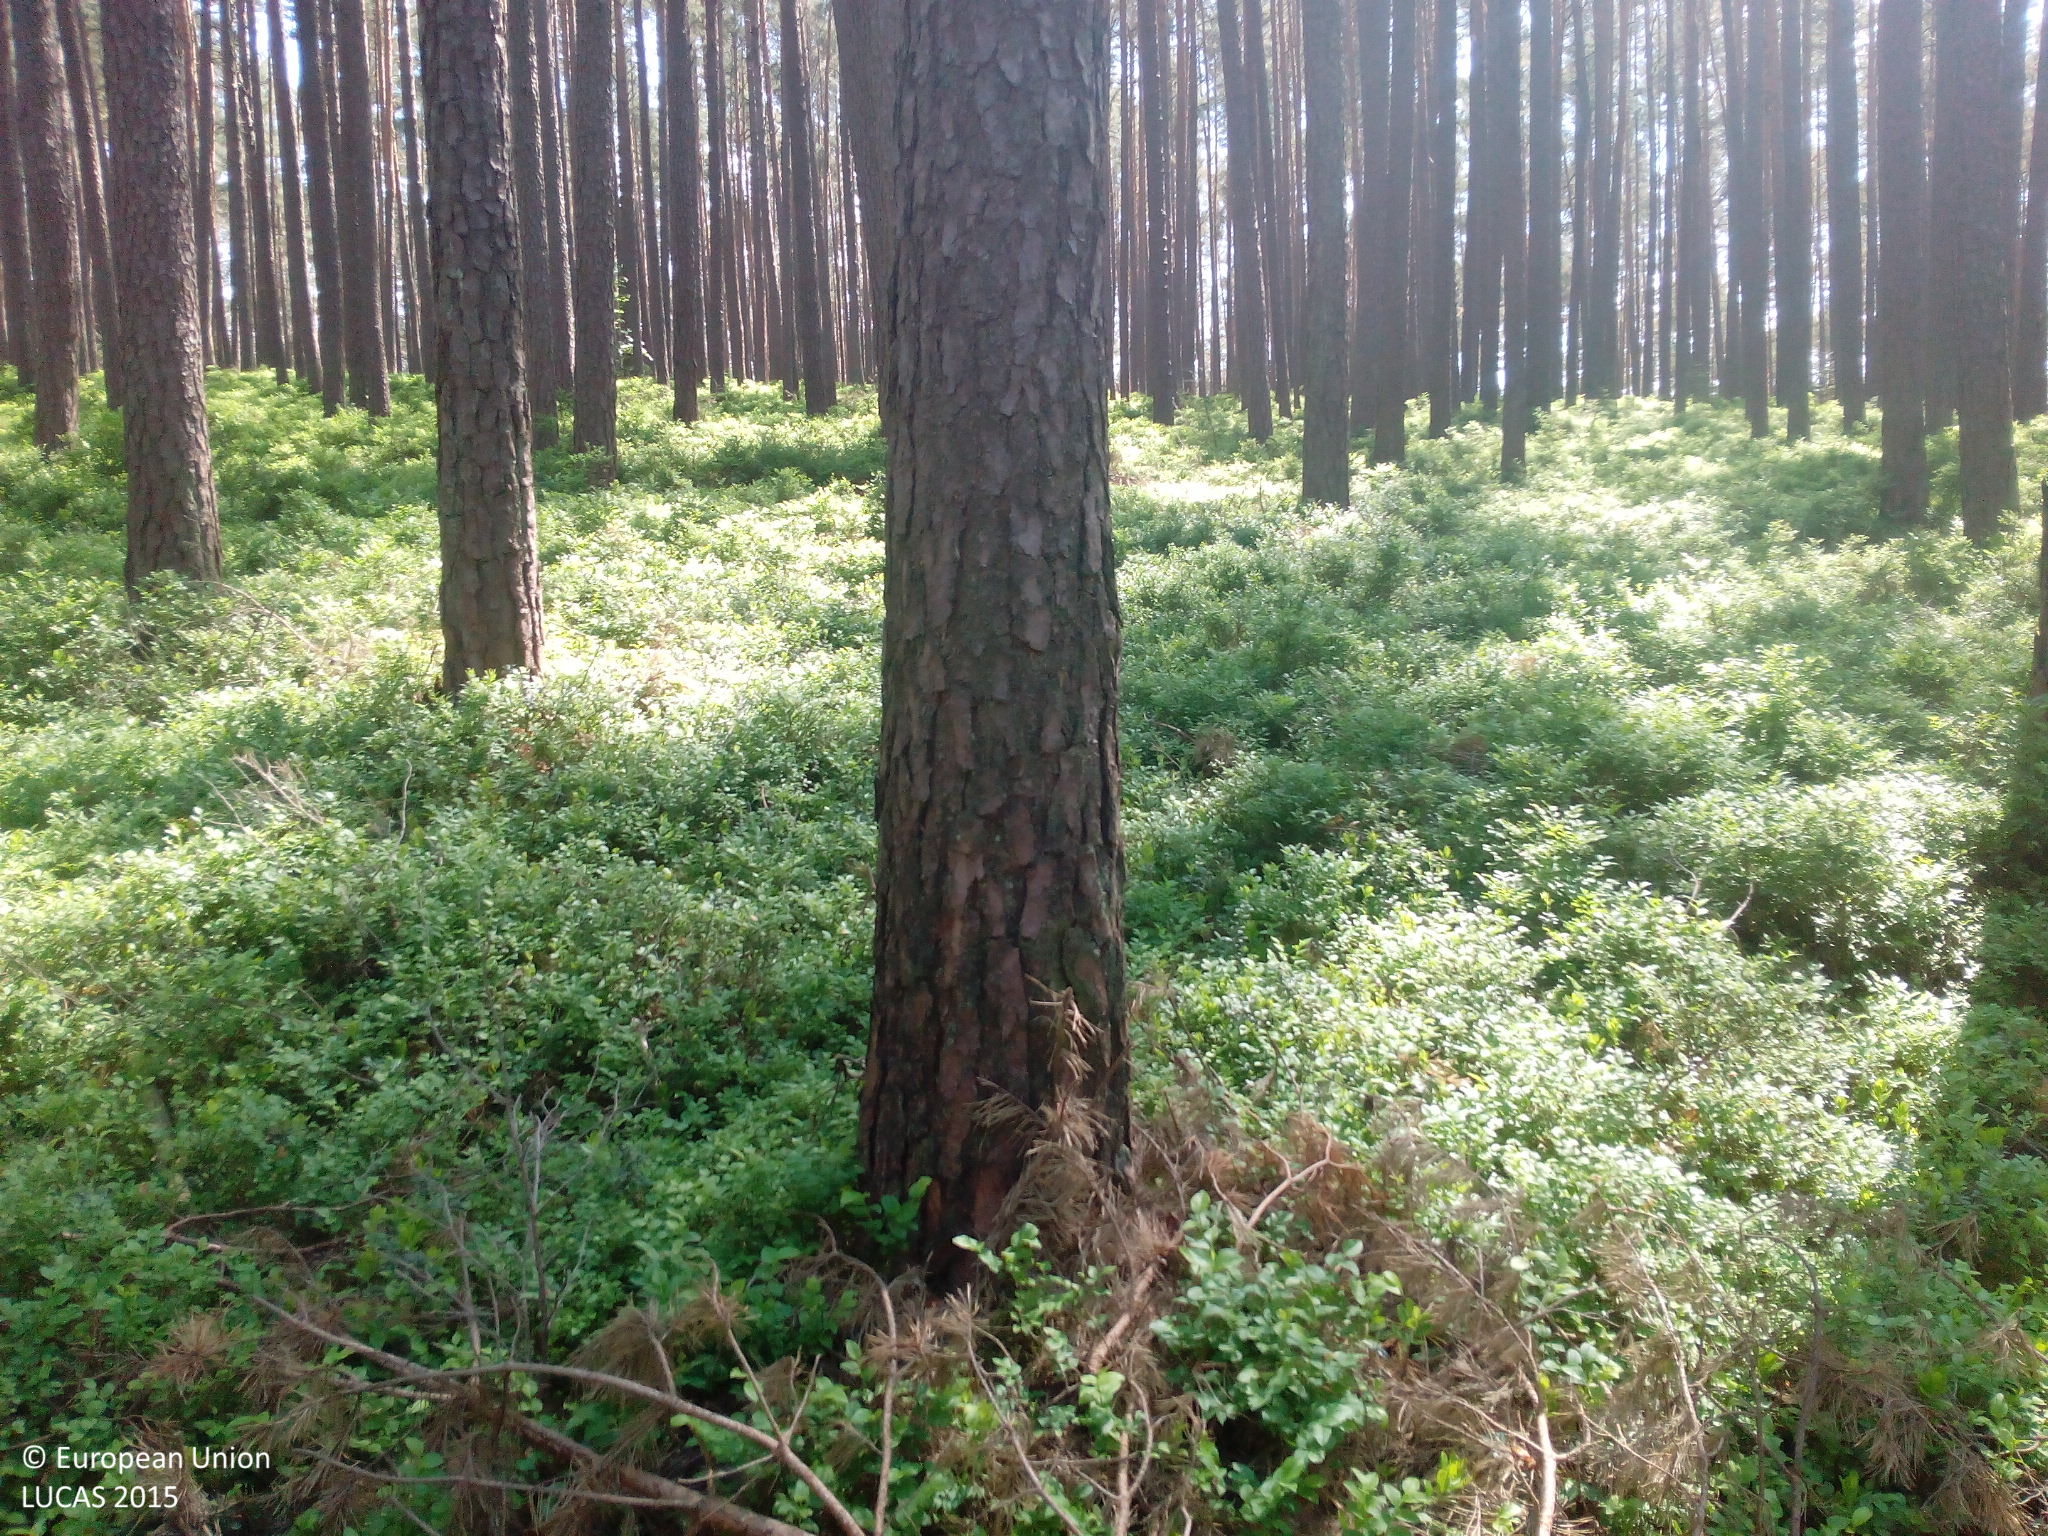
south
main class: Woodland
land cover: Pine dominated coniferous woodland
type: hemiboreal forest and nemoral coniferous forest and mixed broadleaved-coniferous forest
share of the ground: > 75 %
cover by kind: coniferous forest trees 85 %, herbaceous plants 15 %
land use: Forestry
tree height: > 5 m
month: May
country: DE
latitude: 49.1915
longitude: 10.8916
